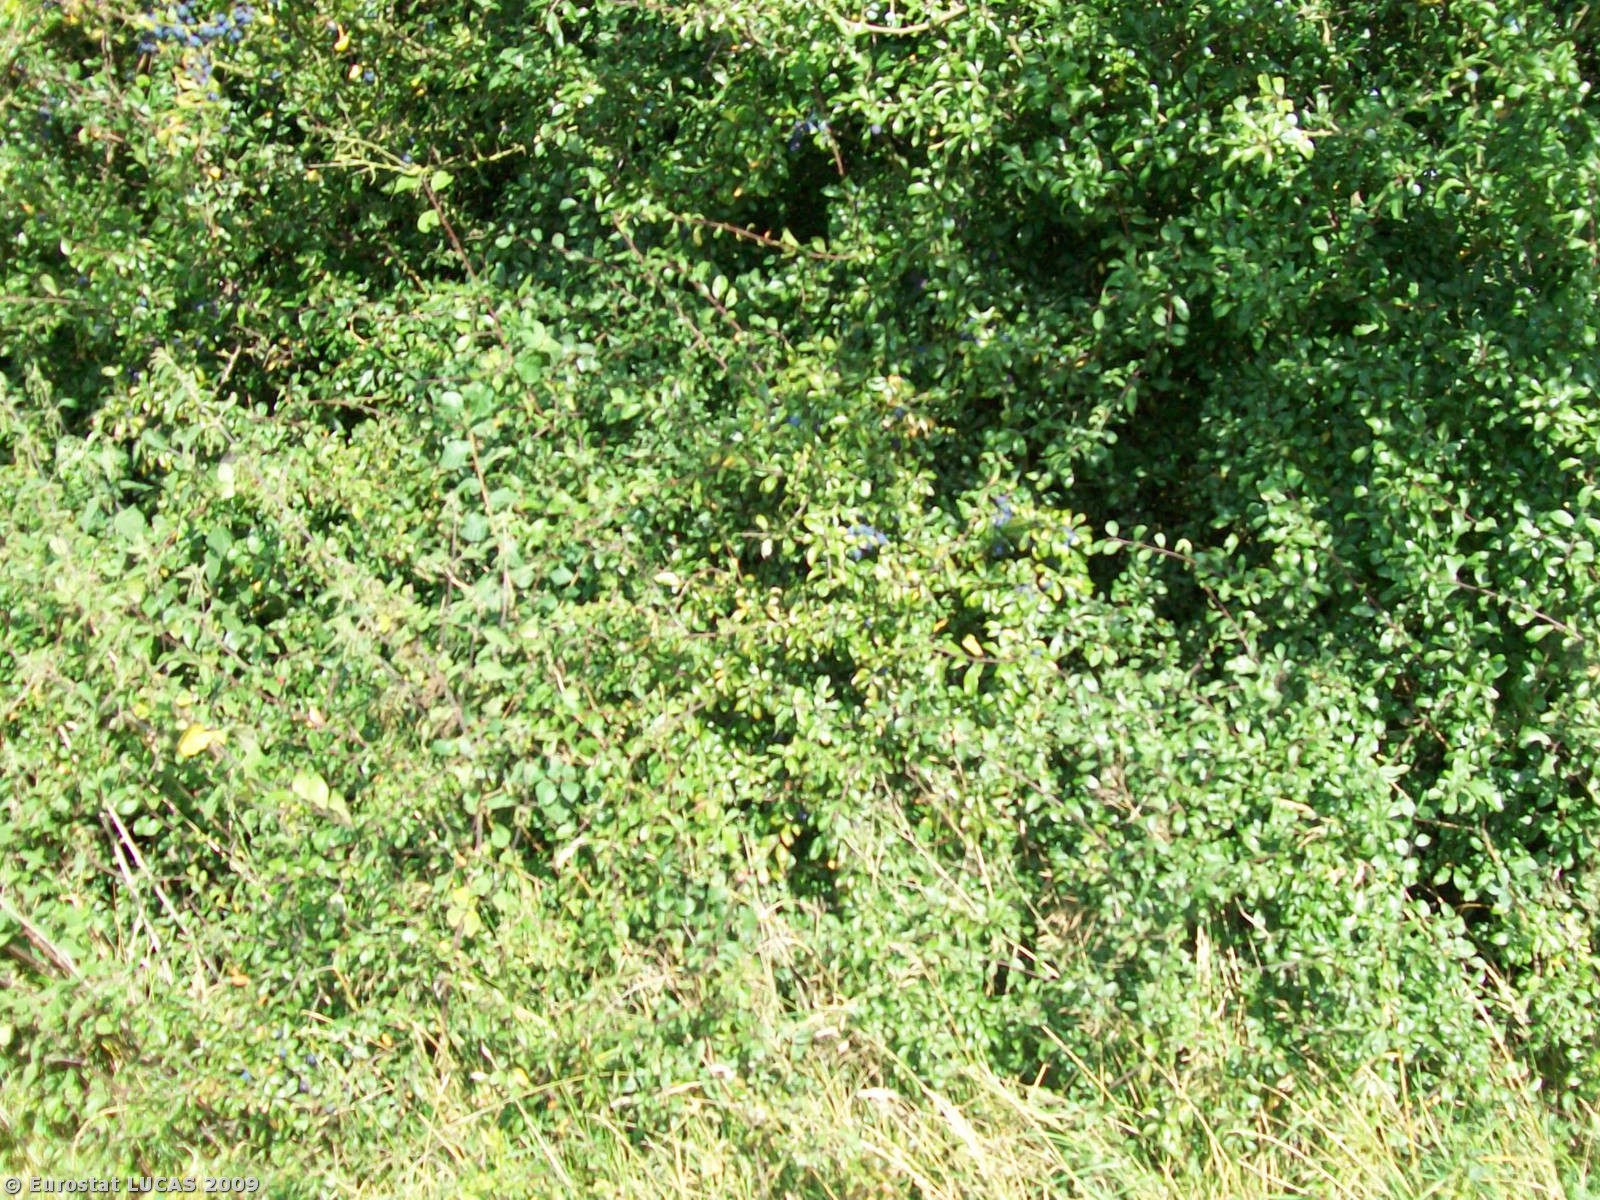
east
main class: Grassland
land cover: Grassland without tree/shrub cover
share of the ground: > 75 %
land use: Agriculture (excluding fallow land and kitchen gardens)
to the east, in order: Grassland without tree/shrub cover; Abandoned hedges; Ditches and canals; Grassland without tree/shrub cover
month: August
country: GB
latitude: 52.4722
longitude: -1.1014
